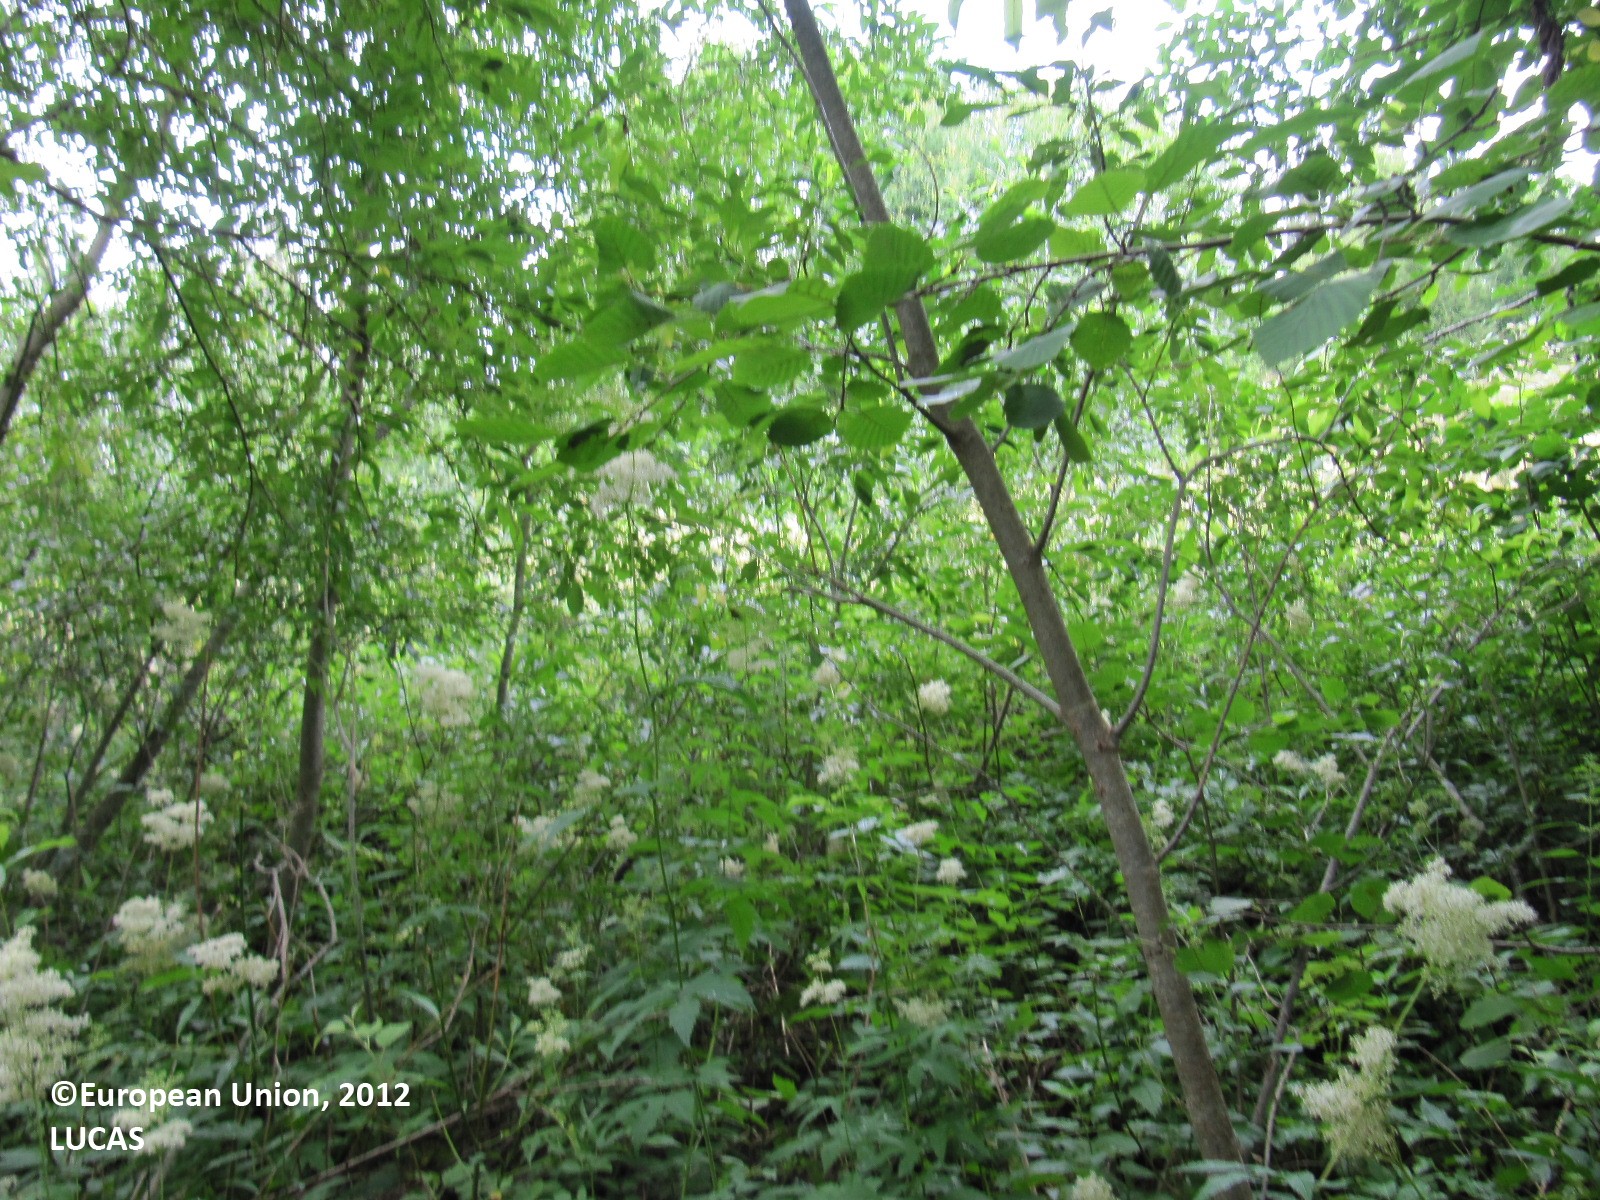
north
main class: Woodland
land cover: Broadleaved woodland
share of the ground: > 75 %
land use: Forestry
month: July
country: FI
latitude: 60.3821
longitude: 23.9363
